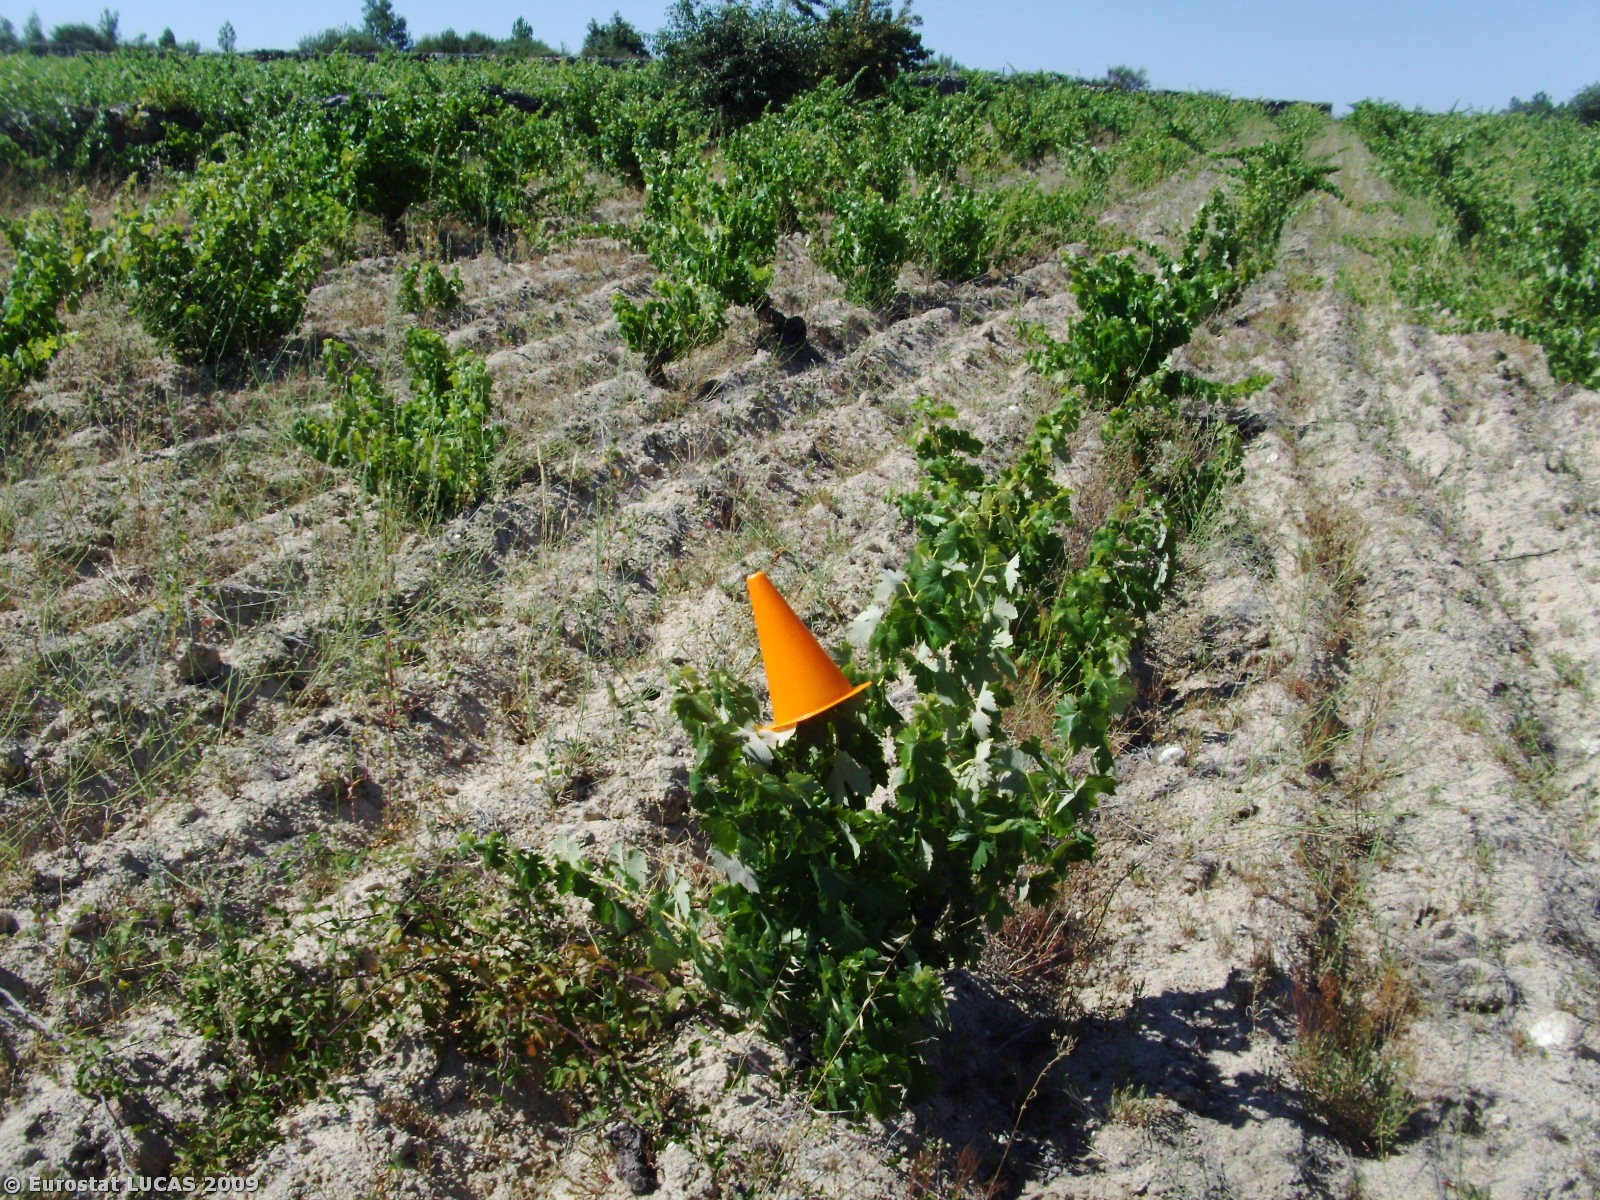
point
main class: Cropland
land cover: Vineyards
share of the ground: 50 - 75 %
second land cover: Bare land
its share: 25 - 50 %
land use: Agriculture (excluding fallow land and kitchen gardens)
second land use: Fallow land
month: July
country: PT
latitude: 40.5029
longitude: -7.0089
